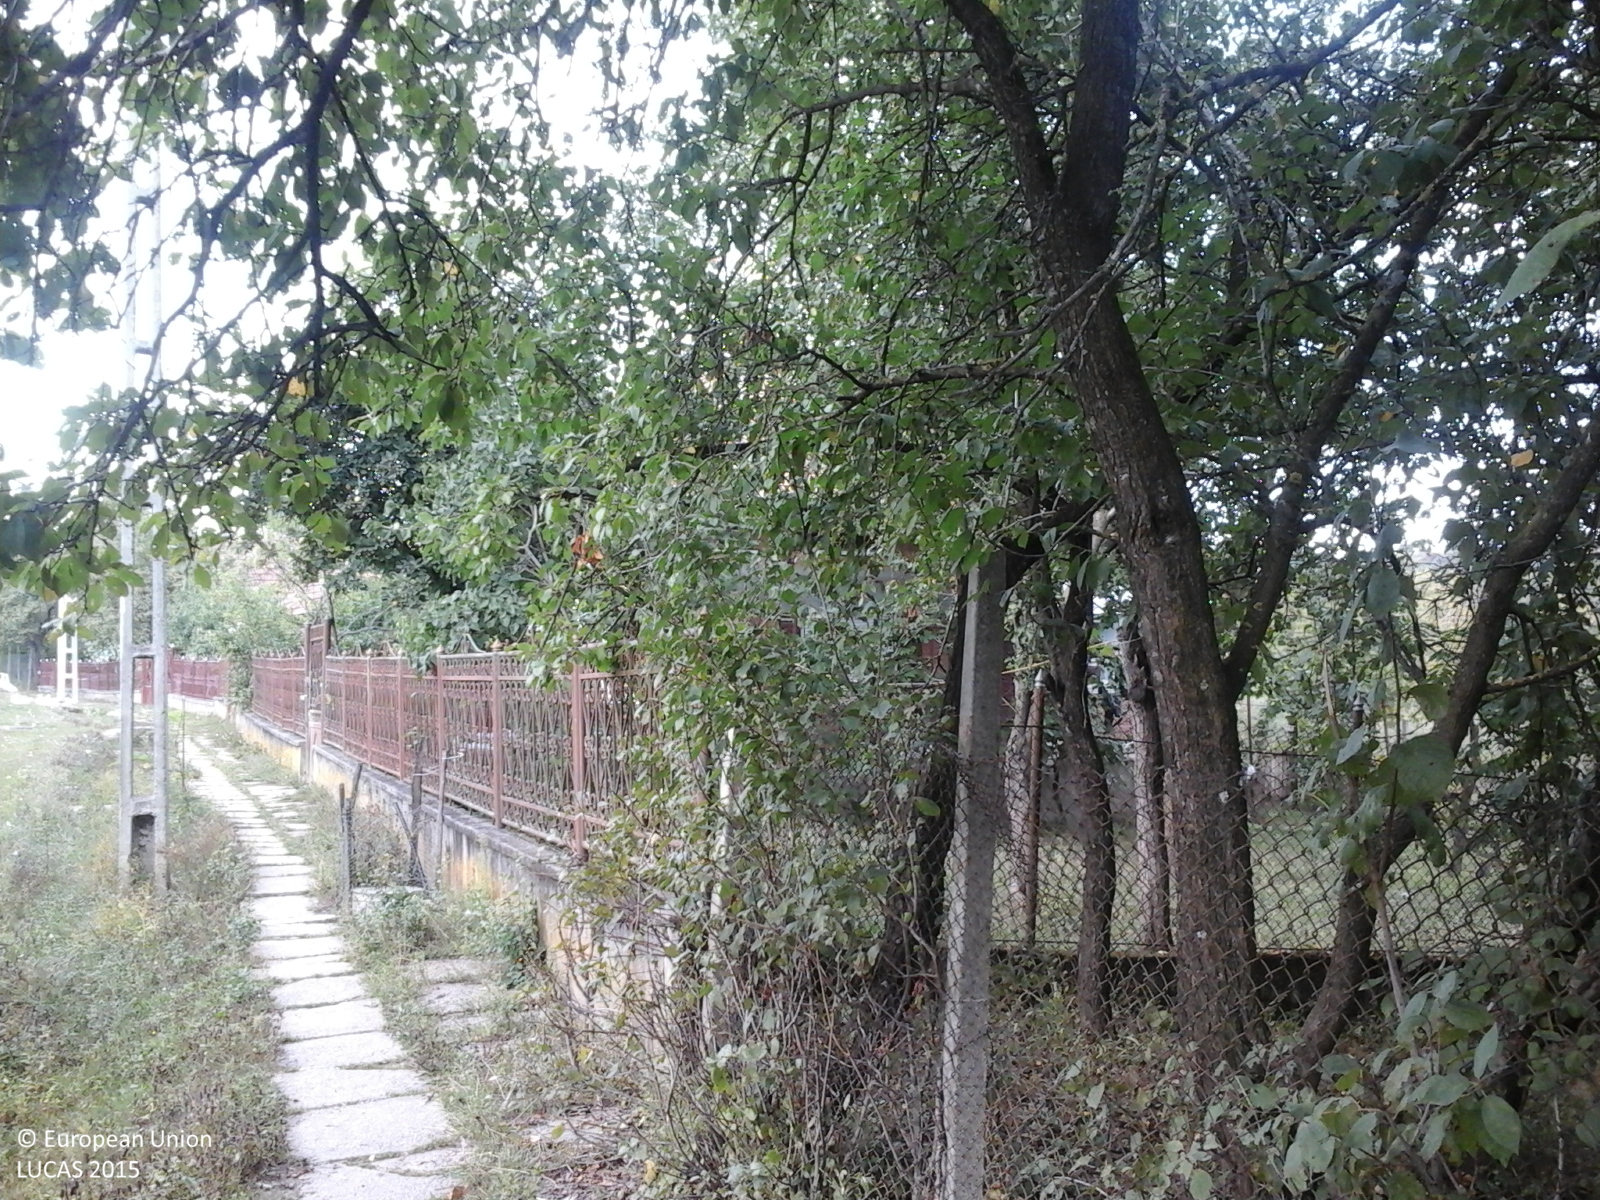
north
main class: Cropland
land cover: Apple fruit
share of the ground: 50 - 75 %
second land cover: Grassland without tree/shrub cover
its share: > 75 %
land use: Agriculture (excluding fallow land and kitchen gardens)
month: September
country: RO
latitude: 47.2930
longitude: 23.0905
